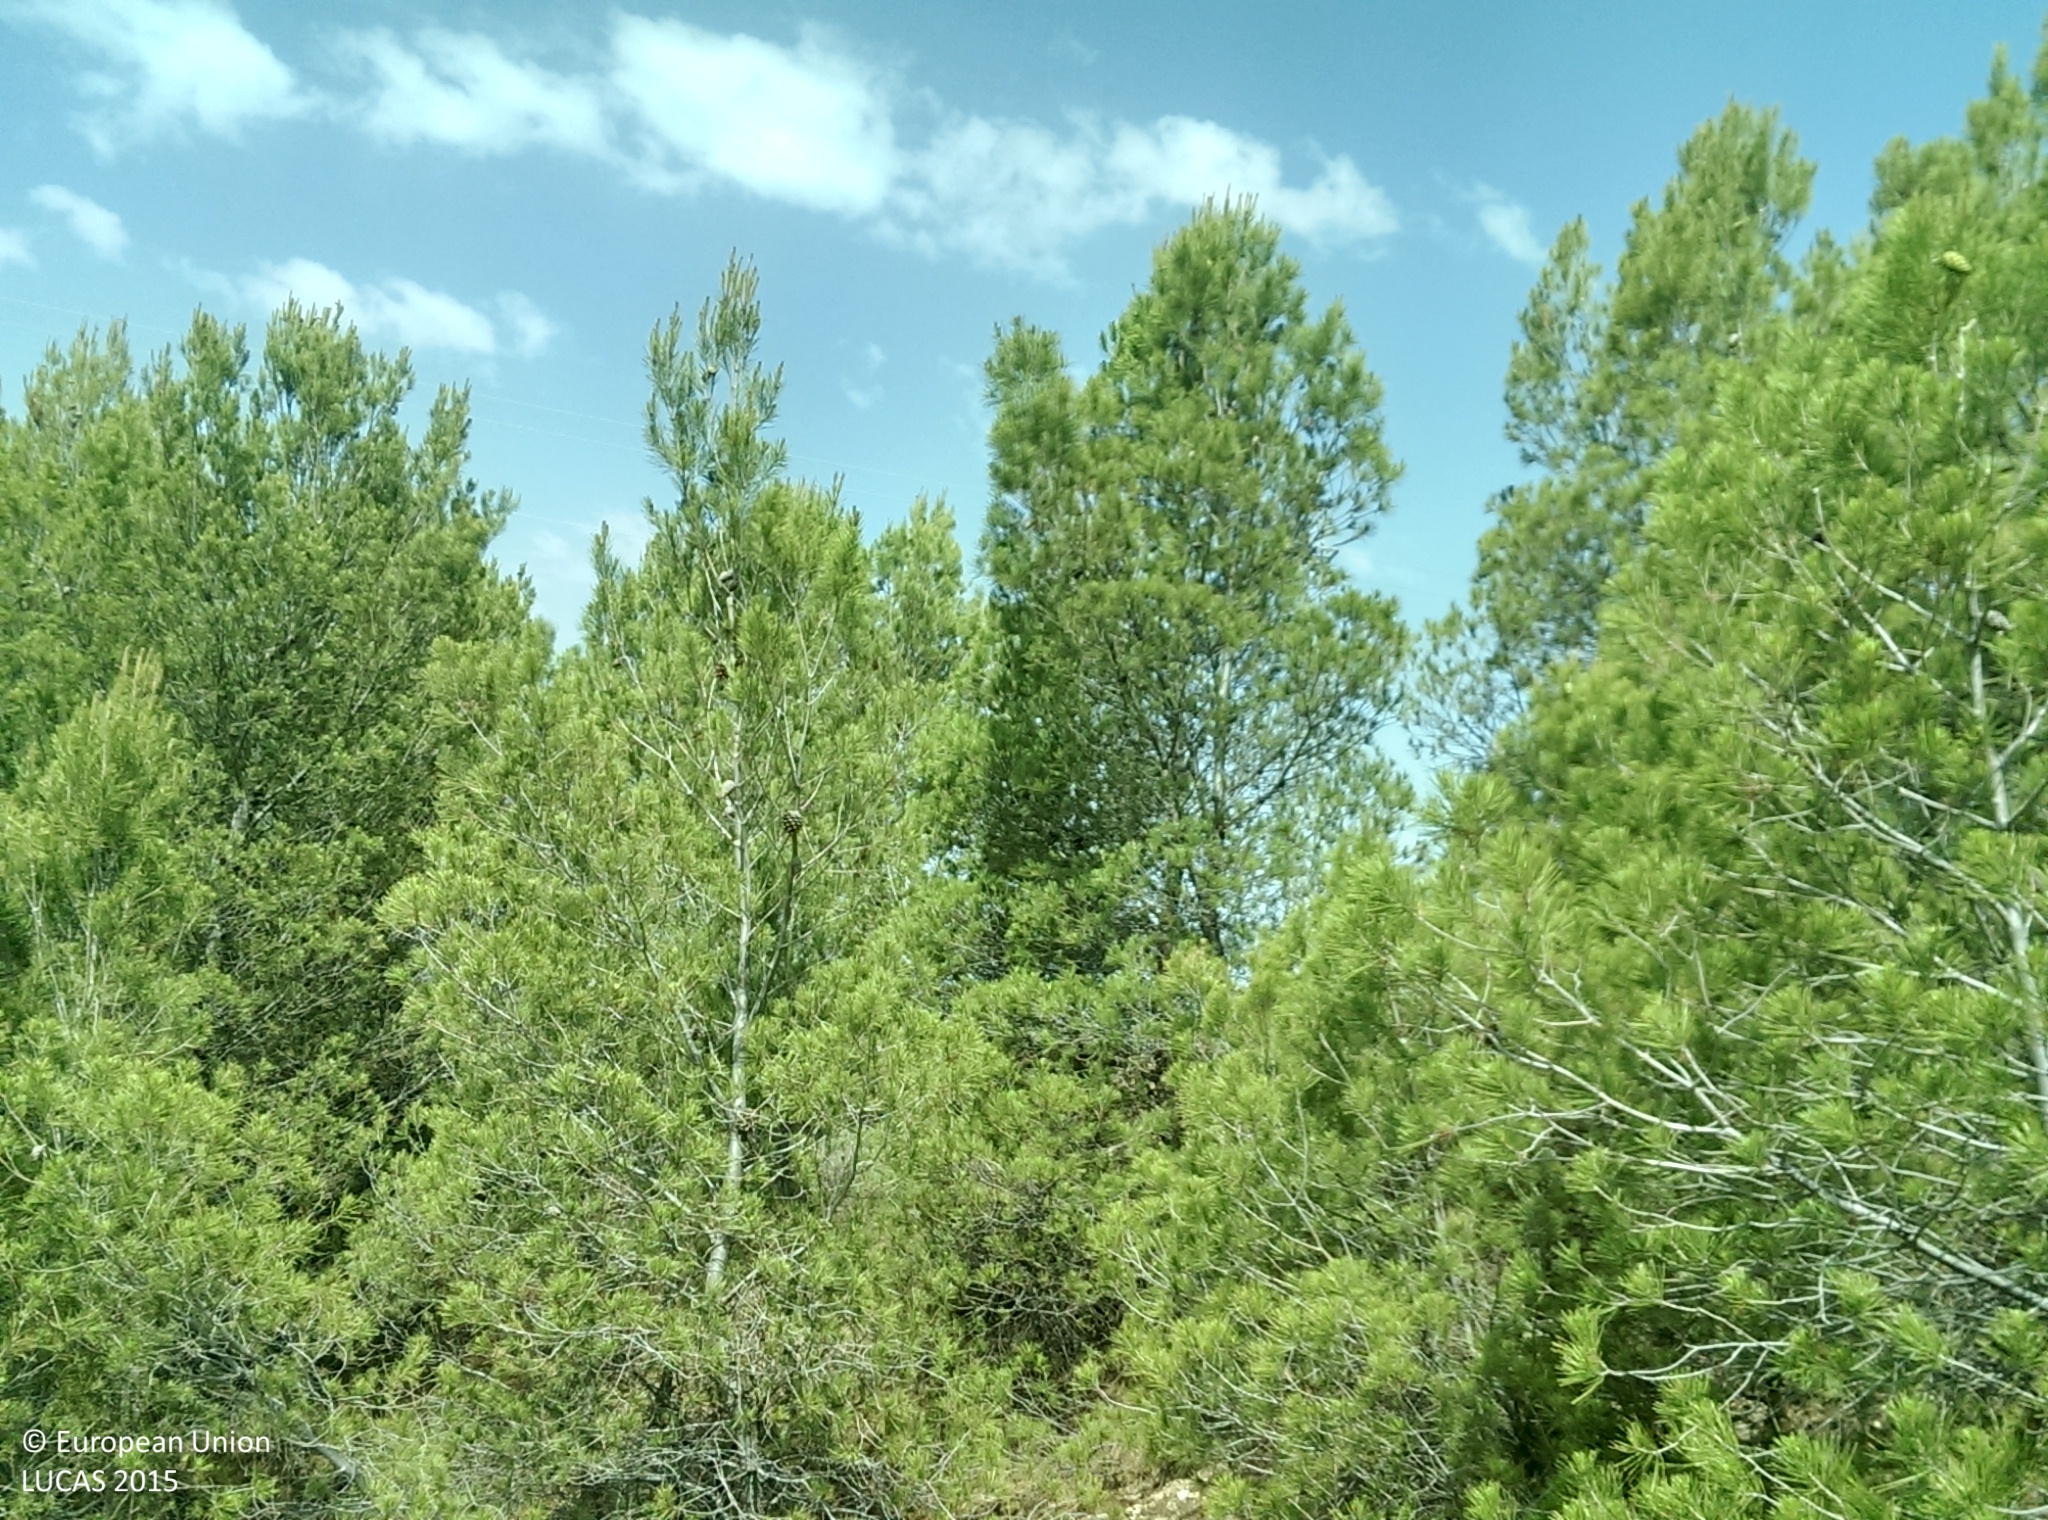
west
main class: Woodland
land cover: Pine dominated coniferous woodland
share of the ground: 50 - 75 %
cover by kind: coniferous forest trees 70 %, herbaceous plants 20 %, unconsolidated bare surface 10 %
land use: Forestry
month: July
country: ES
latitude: 37.5727
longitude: -2.9540
